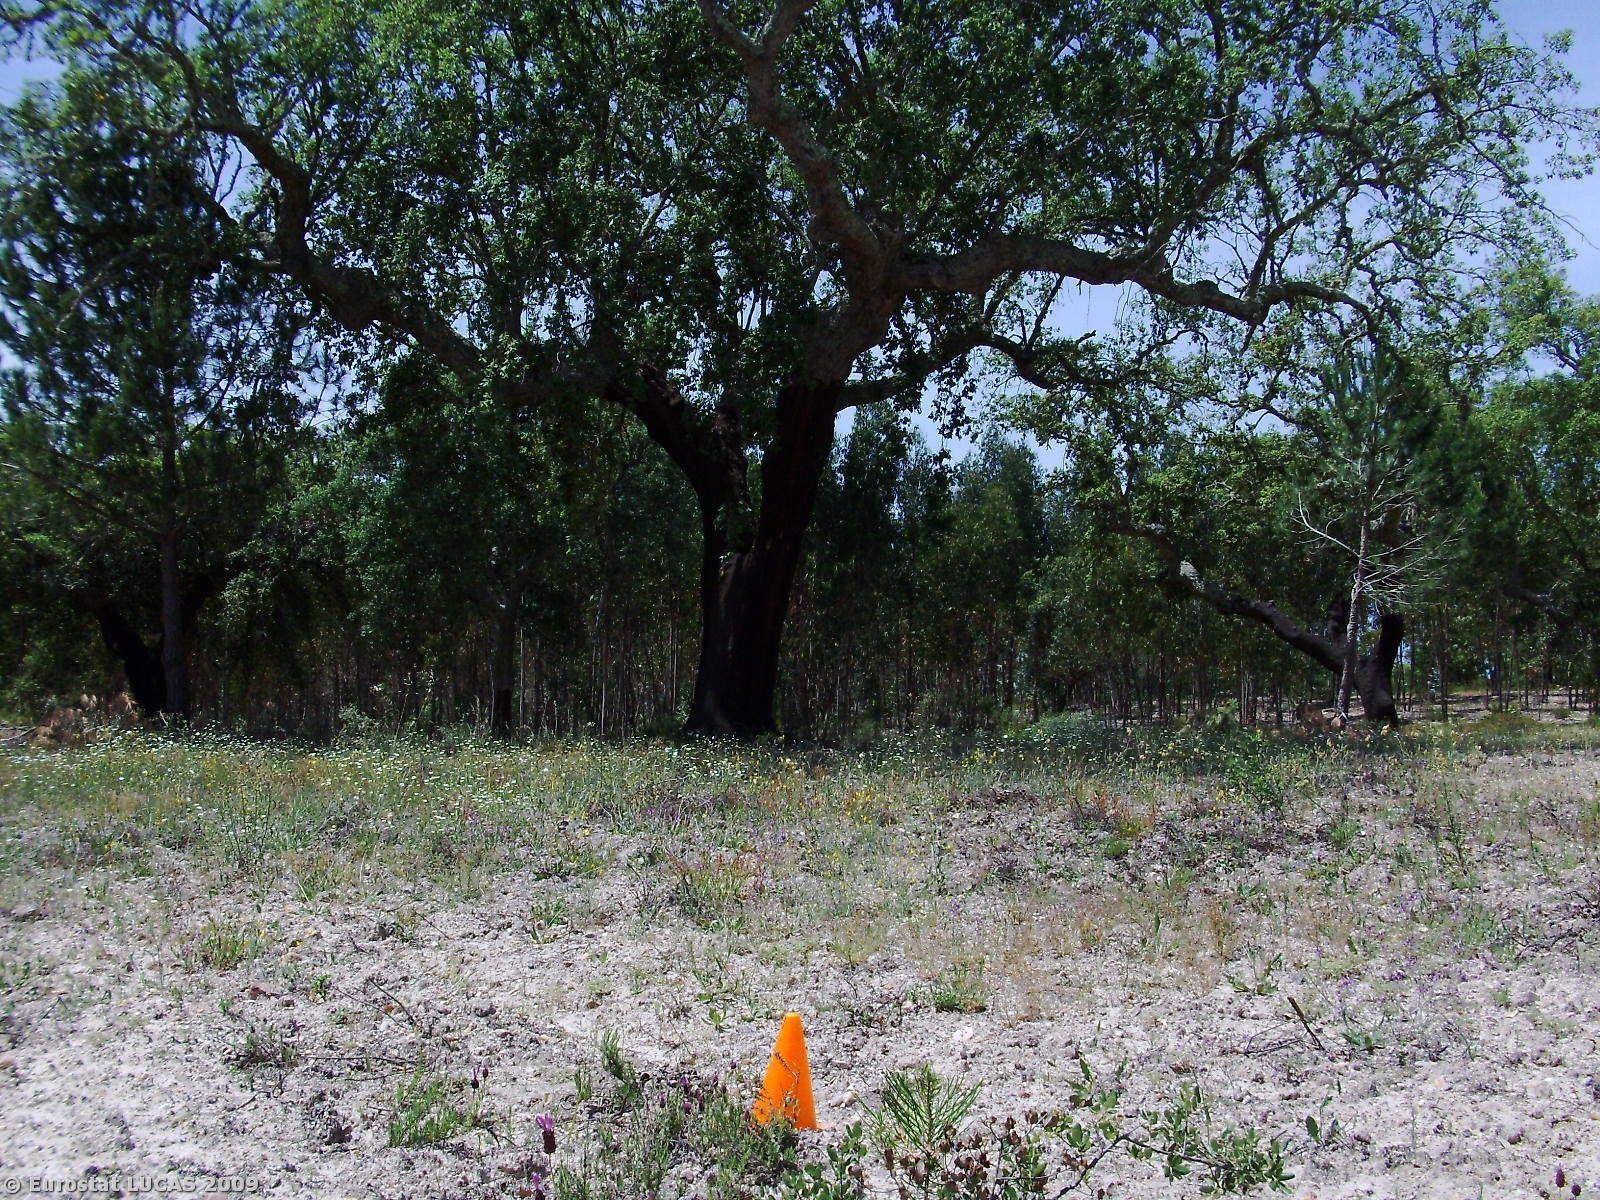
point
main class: Woodland
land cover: Broadleaved woodland
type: broadleaved evergreen forest
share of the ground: 50 - 75 %
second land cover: Bare land
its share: 25 - 50 %
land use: Forestry
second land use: Fallow land
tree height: > 5 m
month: May
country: PT
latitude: 39.1553
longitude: -8.0248
